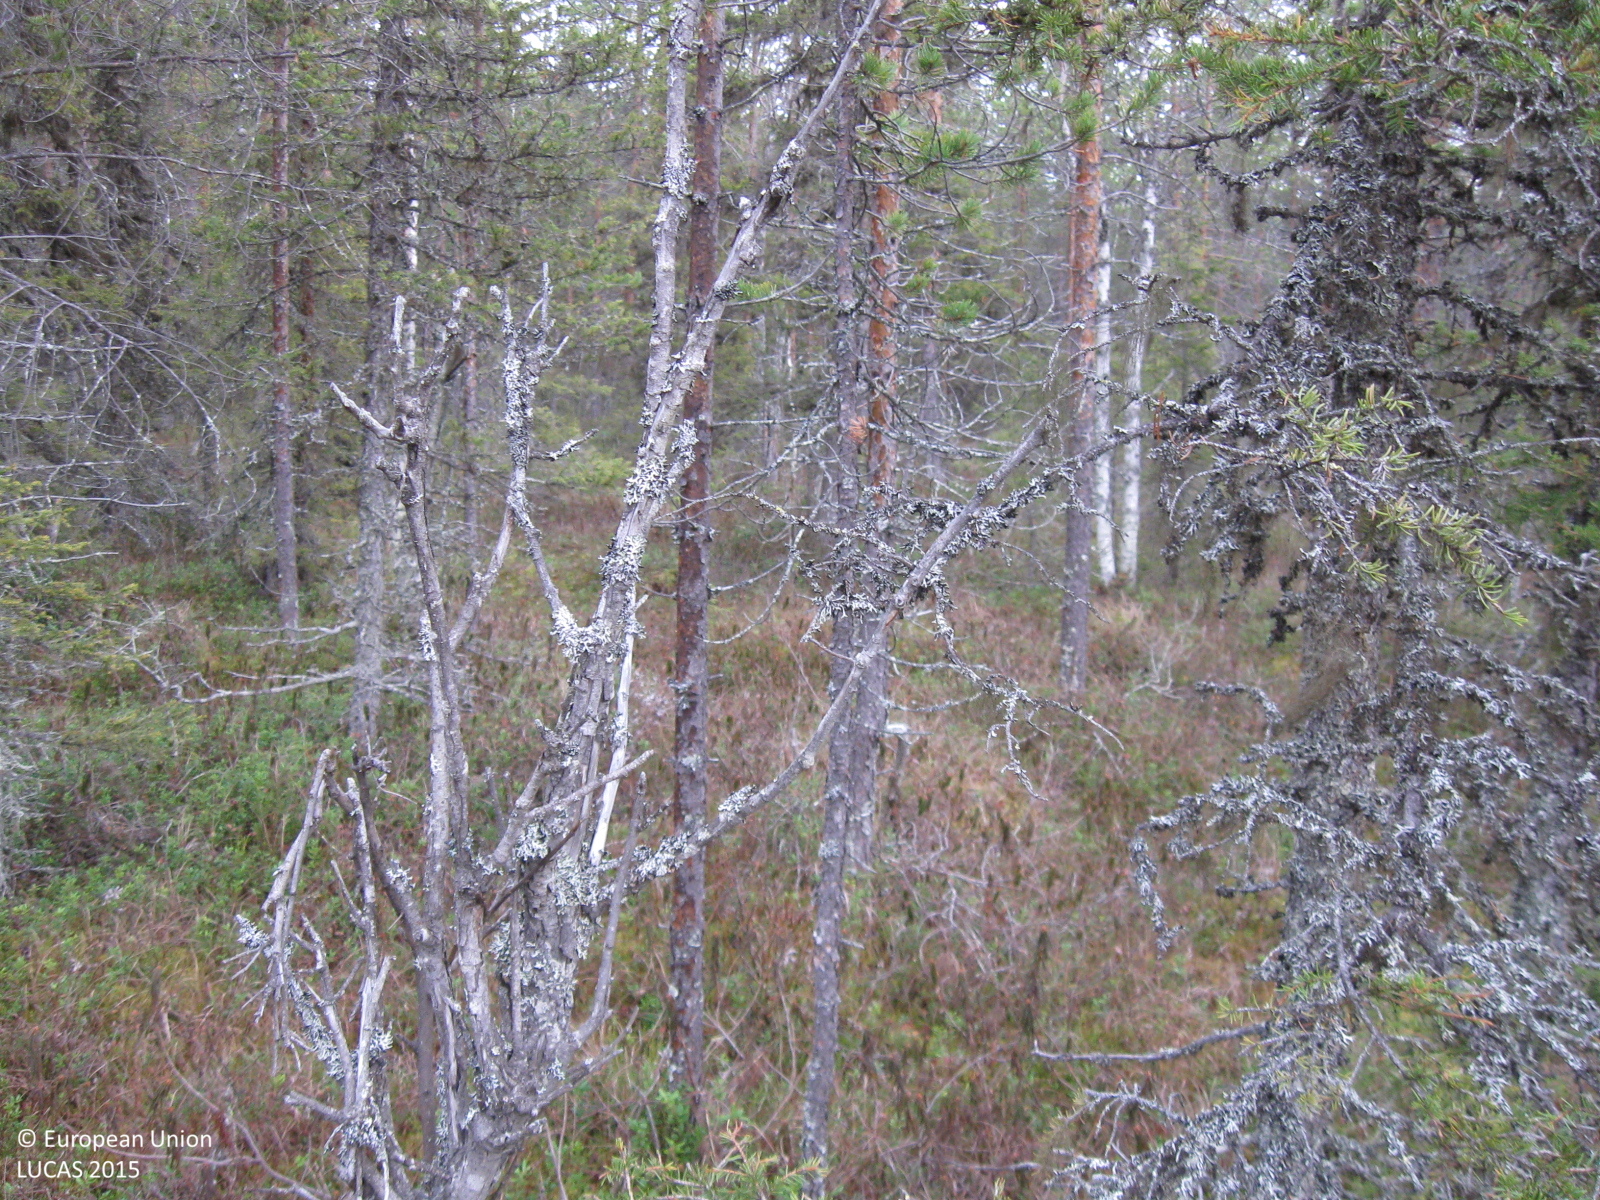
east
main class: Woodland
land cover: Pine dominated coniferous woodland
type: mire and swamp forests
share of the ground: 50 - 75 %
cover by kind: coniferous forest trees 70 %, shrubs 15 %, lichens and mosses 10 %, herbaceous plants 5 %
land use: Forestry
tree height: > 5 m
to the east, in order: Pine dominated coniferous woodland; Spruce dominated coniferous woodland; Pine dominated mixed woodland; Spruce dominated coniferous woodland; Pine dominated coniferous woodland; Spruce dominated coniferous woodland
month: October
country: SE
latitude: 66.5915
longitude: 21.8517
